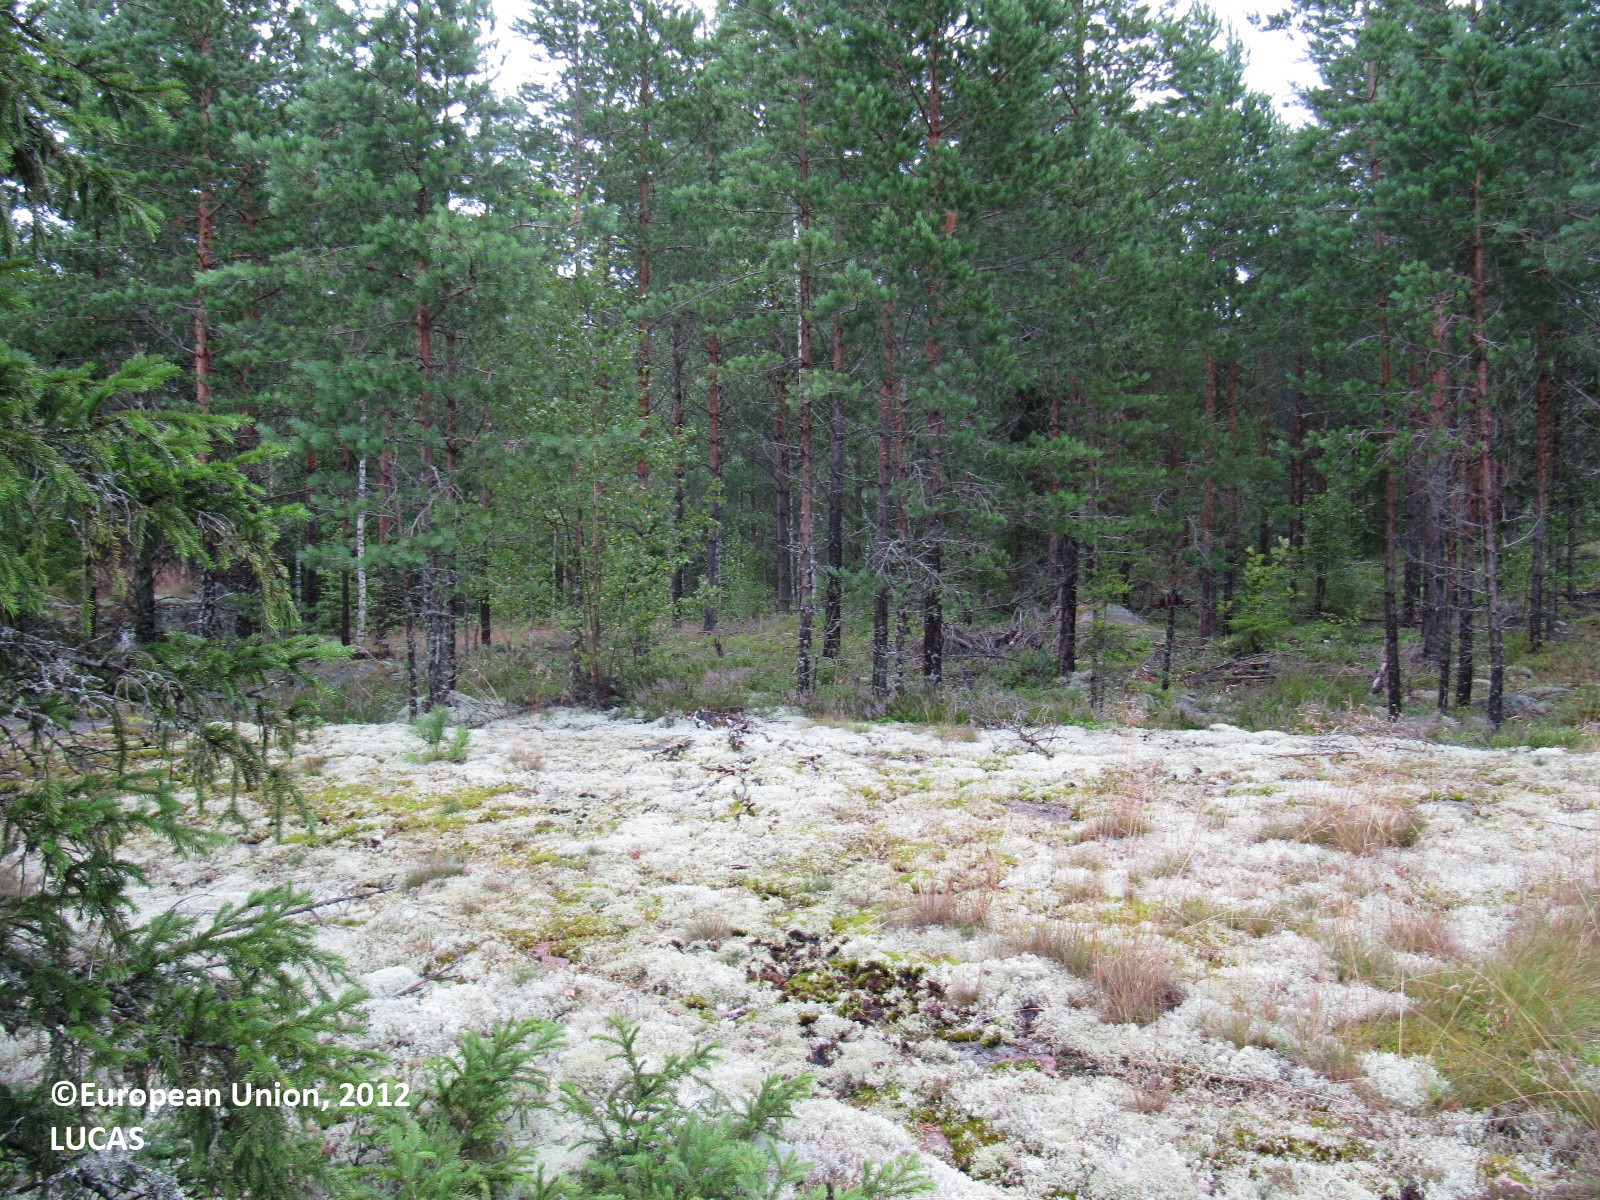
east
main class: Woodland
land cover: Pine dominated coniferous woodland
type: boreal forest
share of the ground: 50 - 75 %
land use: Forestry
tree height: > 5 m
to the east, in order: Pine dominated coniferous woodland; Tracks; Grass margins; Fences; Spruce dominated mixed woodland; Artificial constructions in urban areas; Inland water bodies
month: August
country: FI
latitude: 60.2843
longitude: 23.0476
